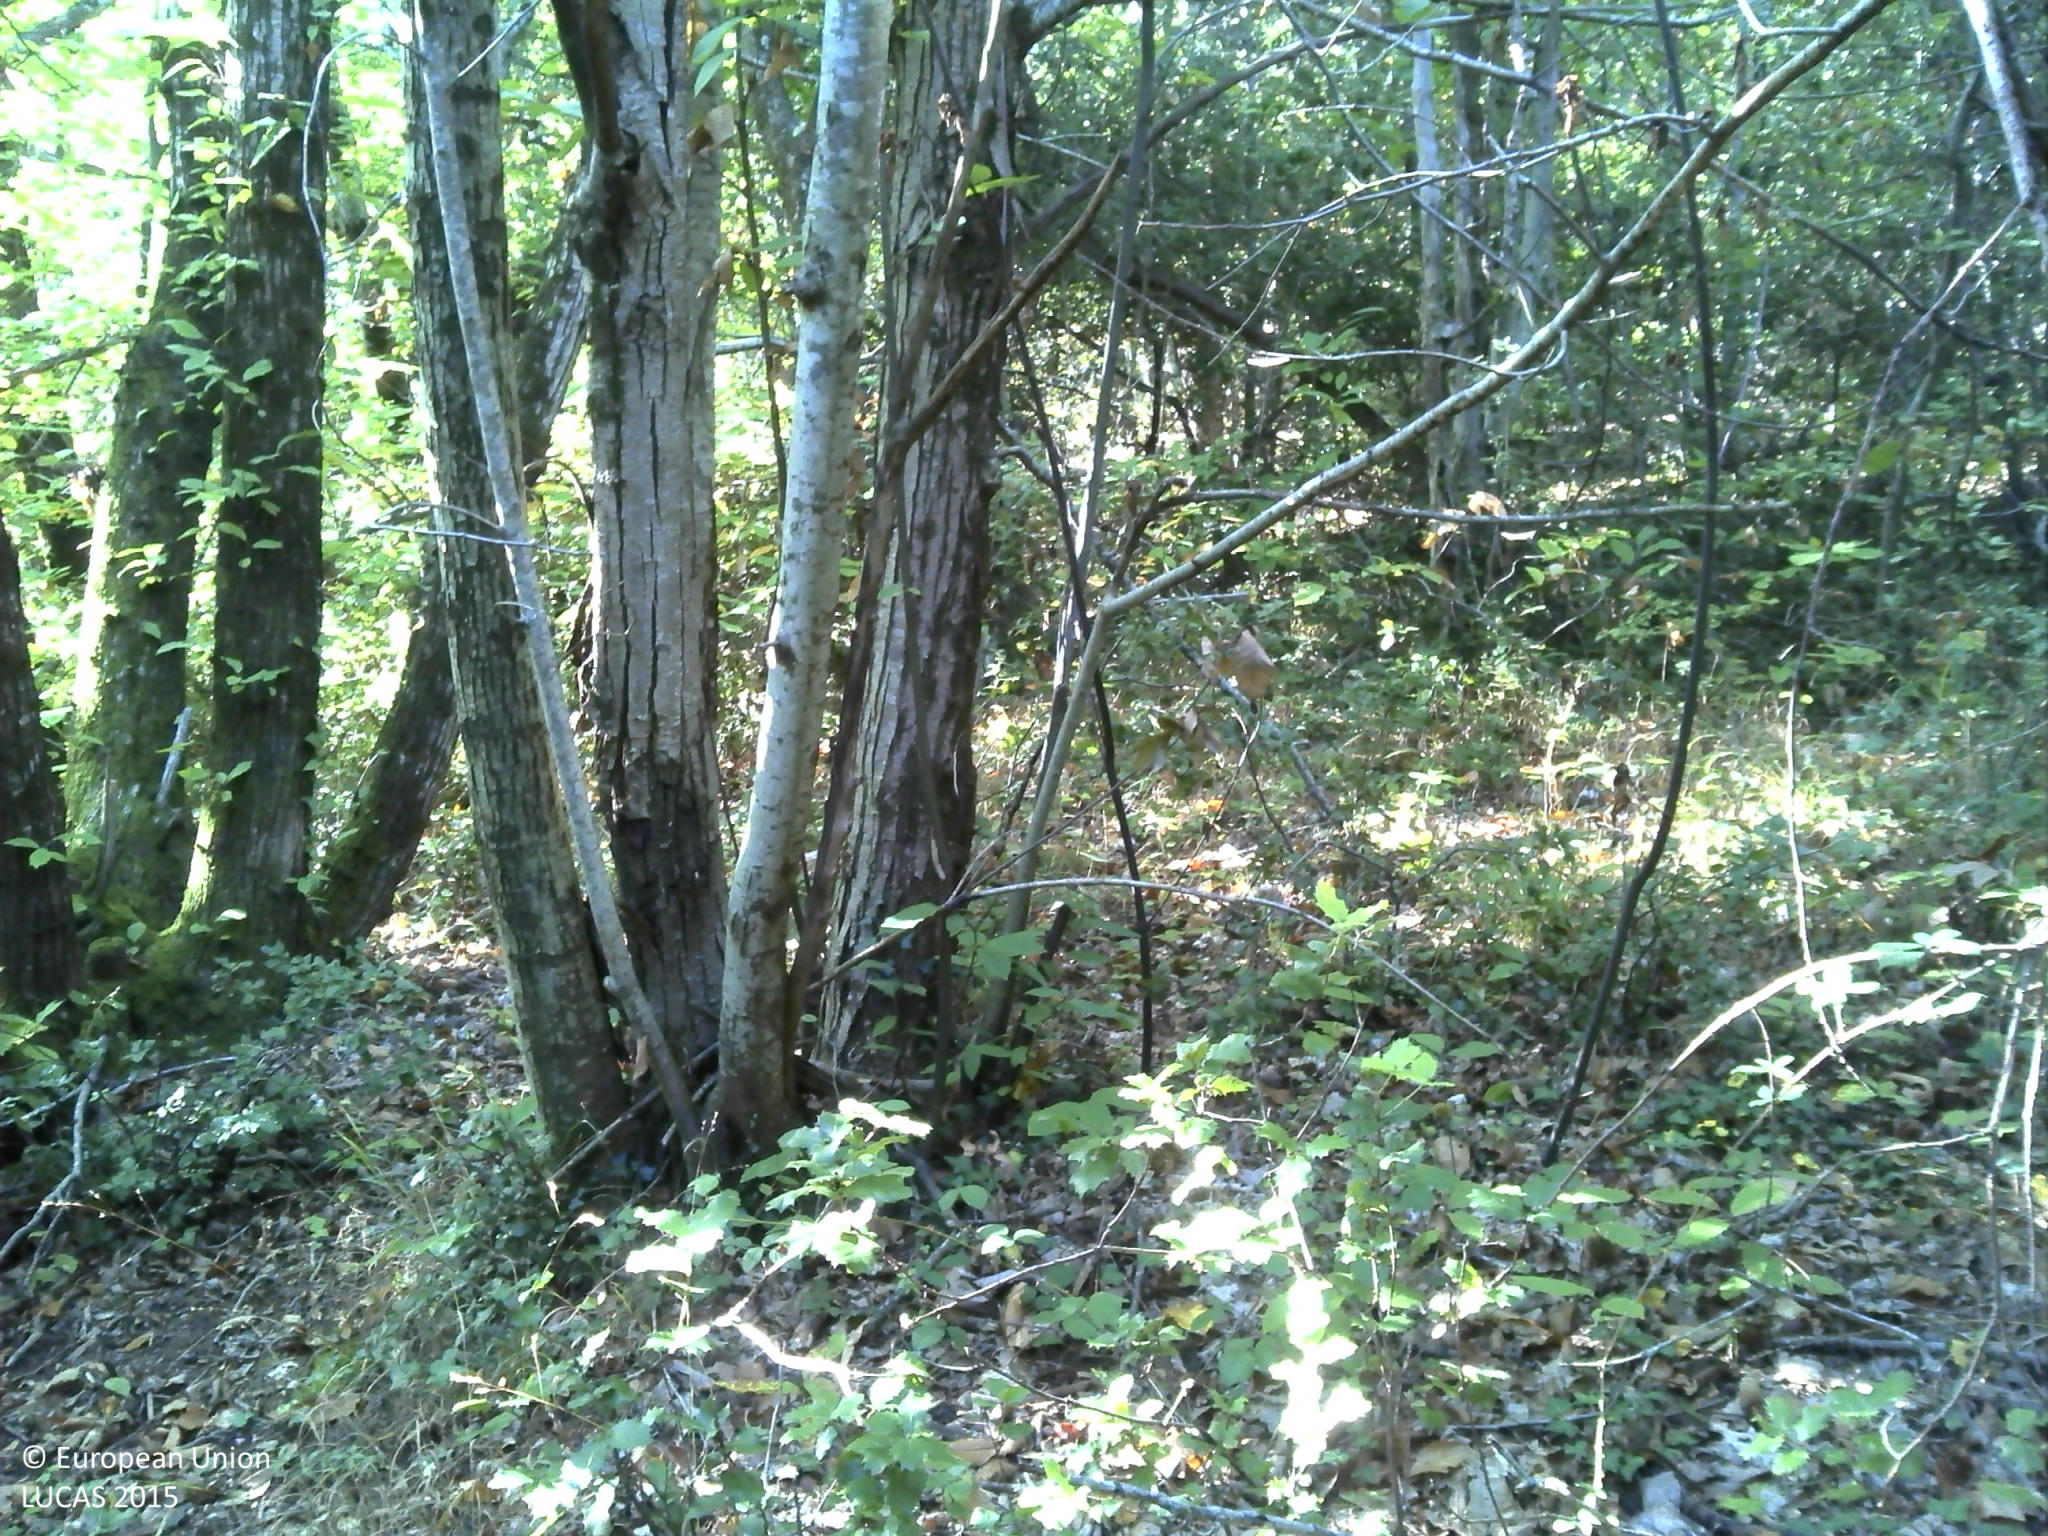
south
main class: Woodland
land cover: Broadleaved woodland
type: thermophilous deciduous forest
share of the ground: > 75 %
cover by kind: broadleaved forest trees 90 %, shrubs 5 %, herbaceous plants 5 %
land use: Forestry
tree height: > 5 m
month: October
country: FR
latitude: 43.5915
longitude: 3.3076
